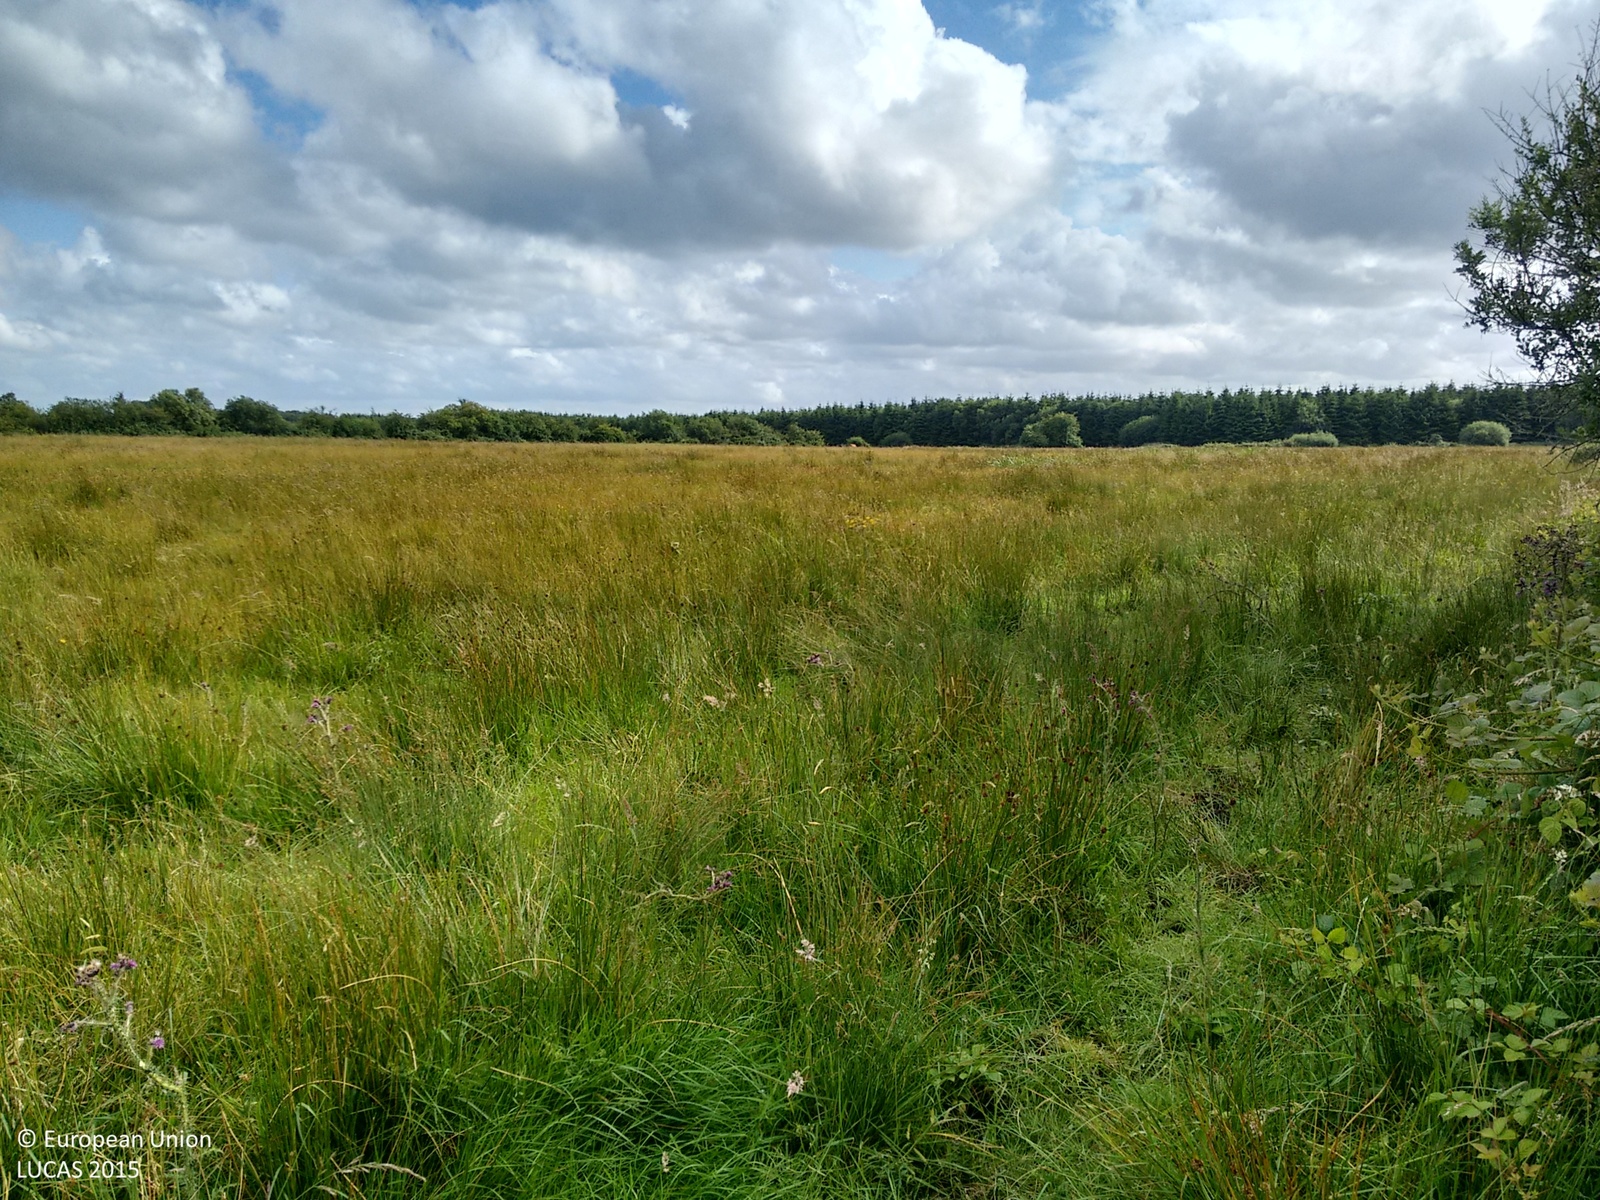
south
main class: Woodland
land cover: Pine dominated coniferous woodland
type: exotic forest
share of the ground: > 75 %
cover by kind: coniferous forest trees 90 %, broadleaved forest trees 5 %, shrubs 5 %
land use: Forestry
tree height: > 5 m
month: July
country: IE
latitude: 53.6240
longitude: -7.7504
